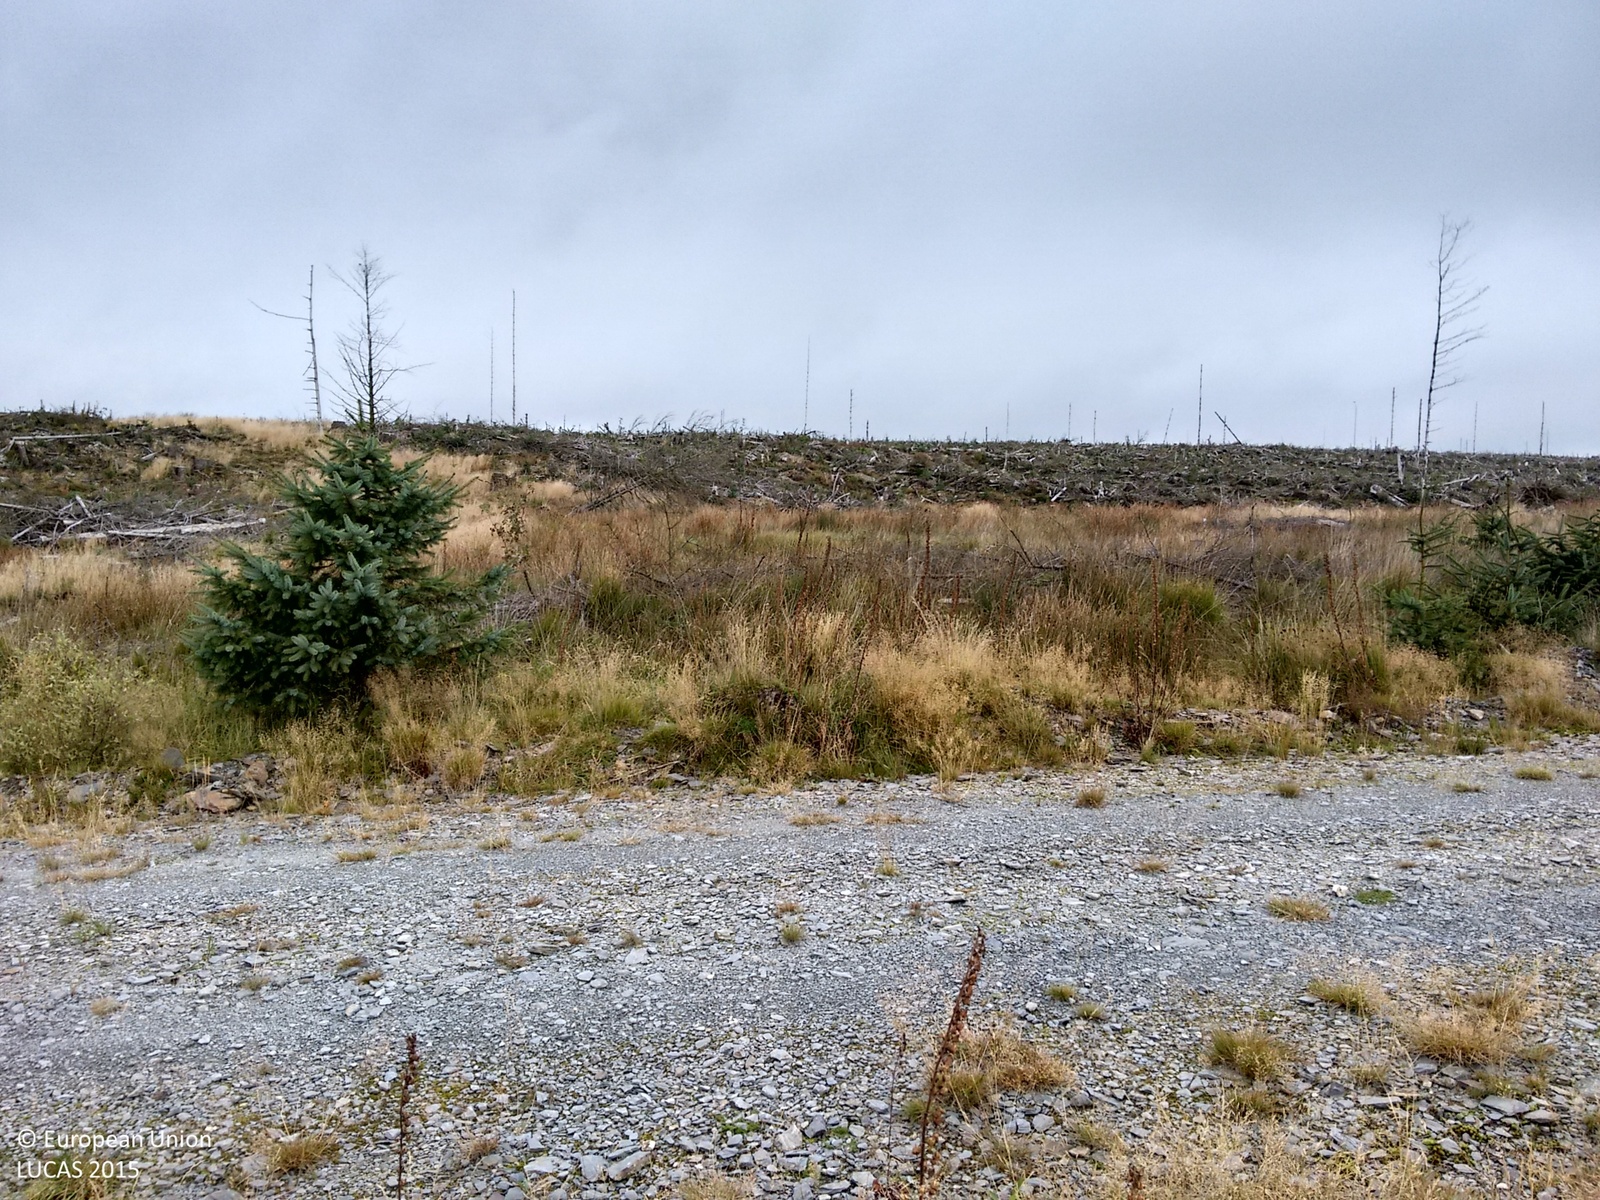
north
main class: Woodland
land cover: Spruce dominated coniferous woodland
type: exotic forest
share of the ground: > 75 %
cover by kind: coniferous forest trees 70 %, herbaceous plants 30 %
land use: Forestry
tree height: < 5 m
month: September
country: GB
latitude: 52.1589
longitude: -3.7273
